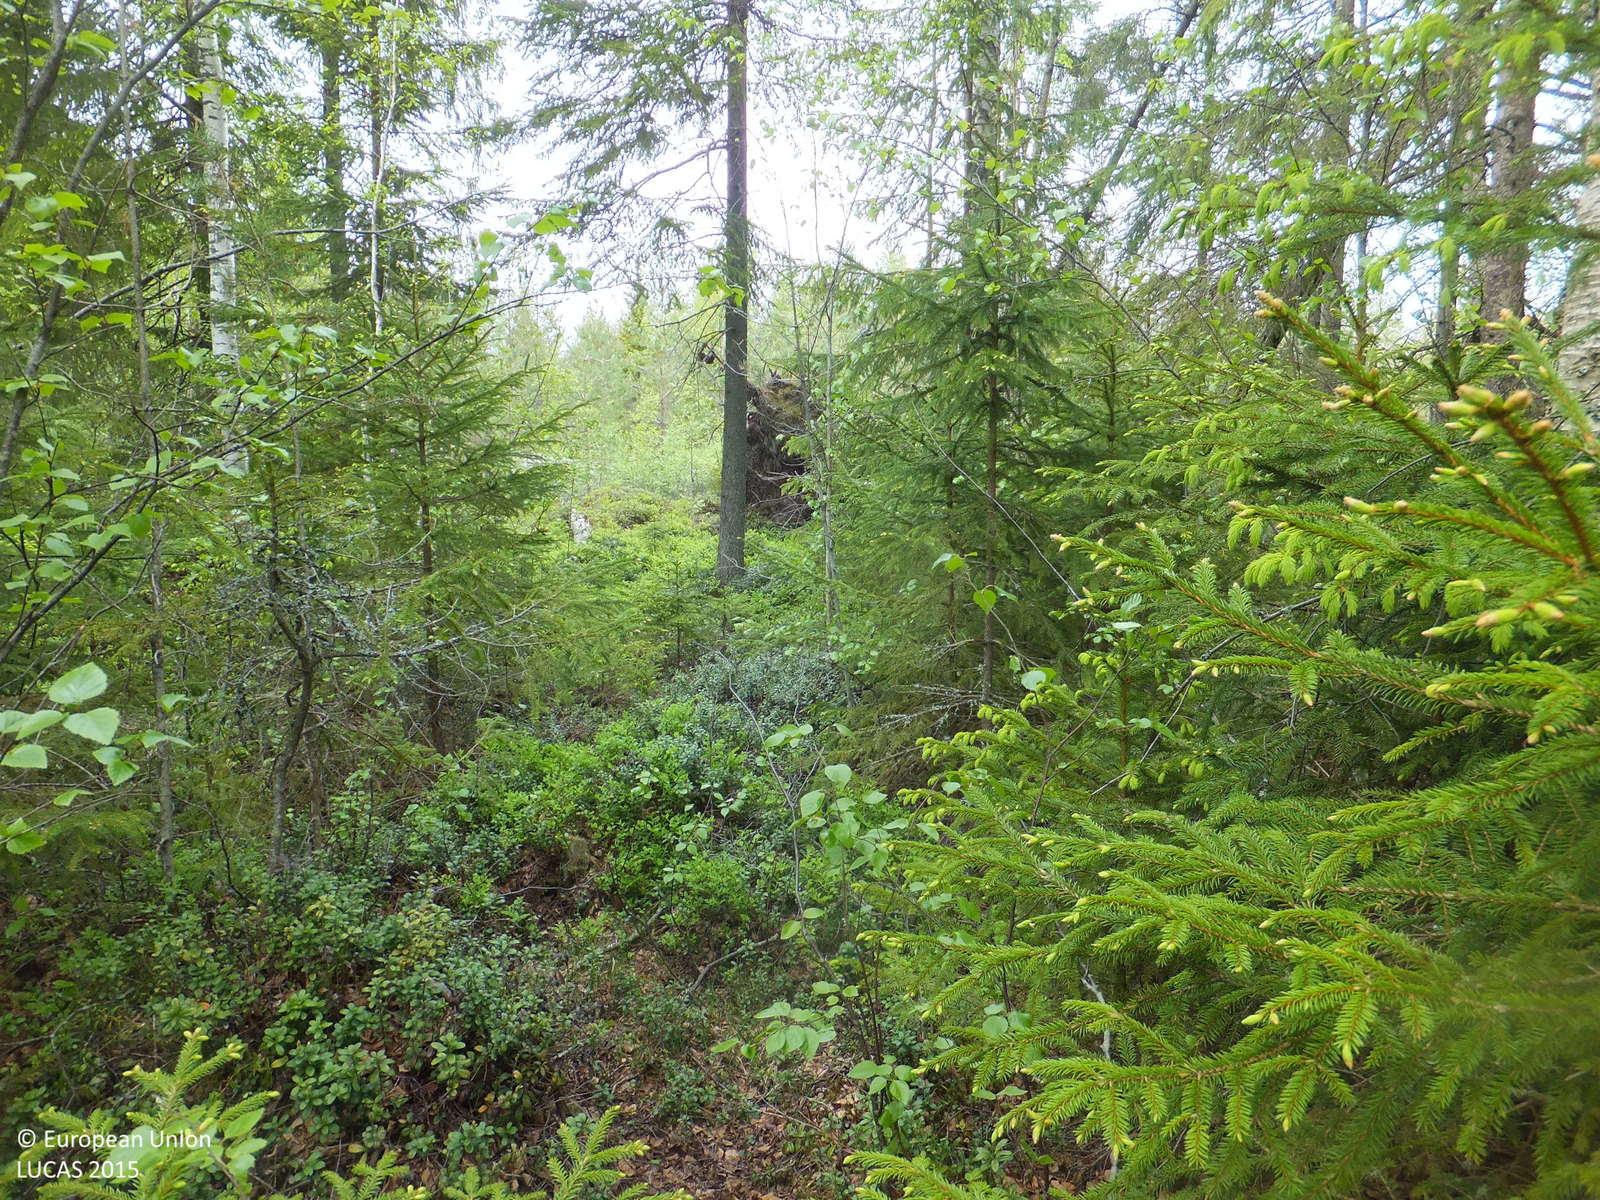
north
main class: Woodland
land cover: Spruce dominated mixed woodland
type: boreal forest
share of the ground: 50 - 75 %
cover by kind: broadleaved forest trees 50 %, shrubs 30 %, coniferous forest trees 20 %
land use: Forestry
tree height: > 5 m
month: June
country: FI
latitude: 63.5129
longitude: 22.3240
